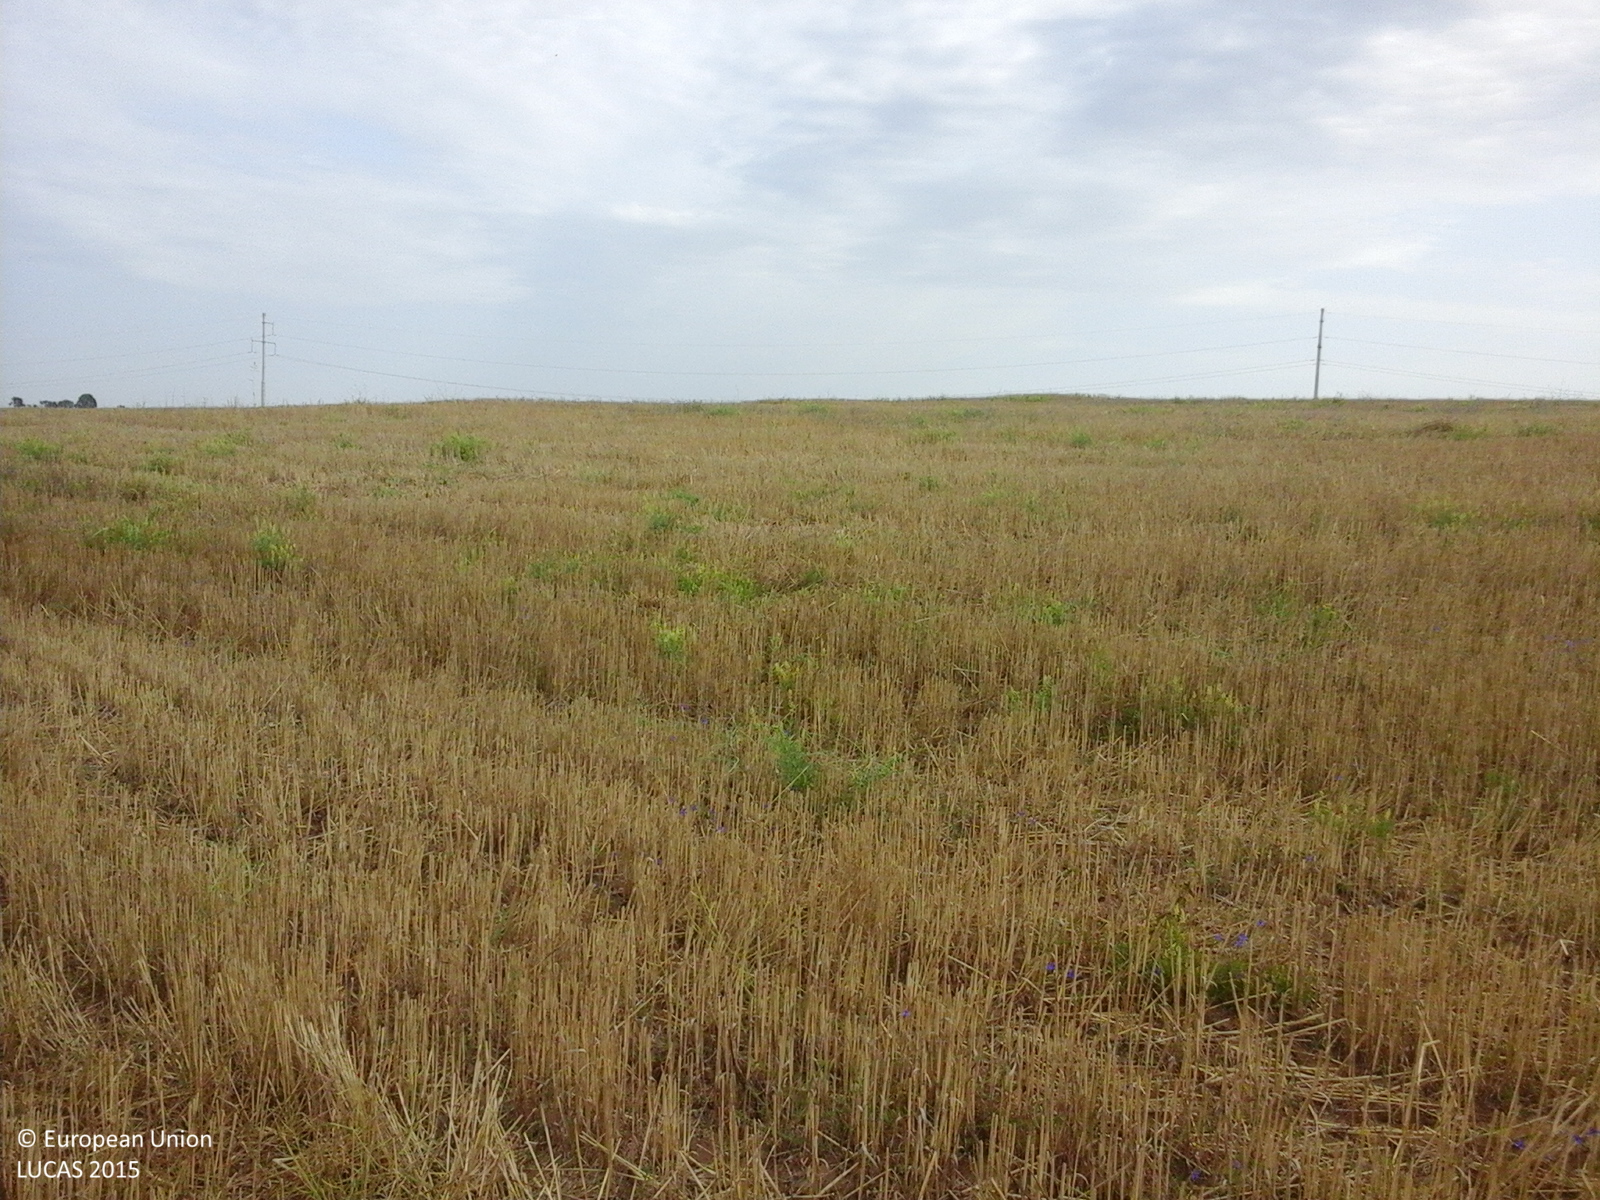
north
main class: Cropland
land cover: Common wheat
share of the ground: > 75 %
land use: Agriculture (excluding fallow land and kitchen gardens)
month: August
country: RO
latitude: 44.0614
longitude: 27.7343
